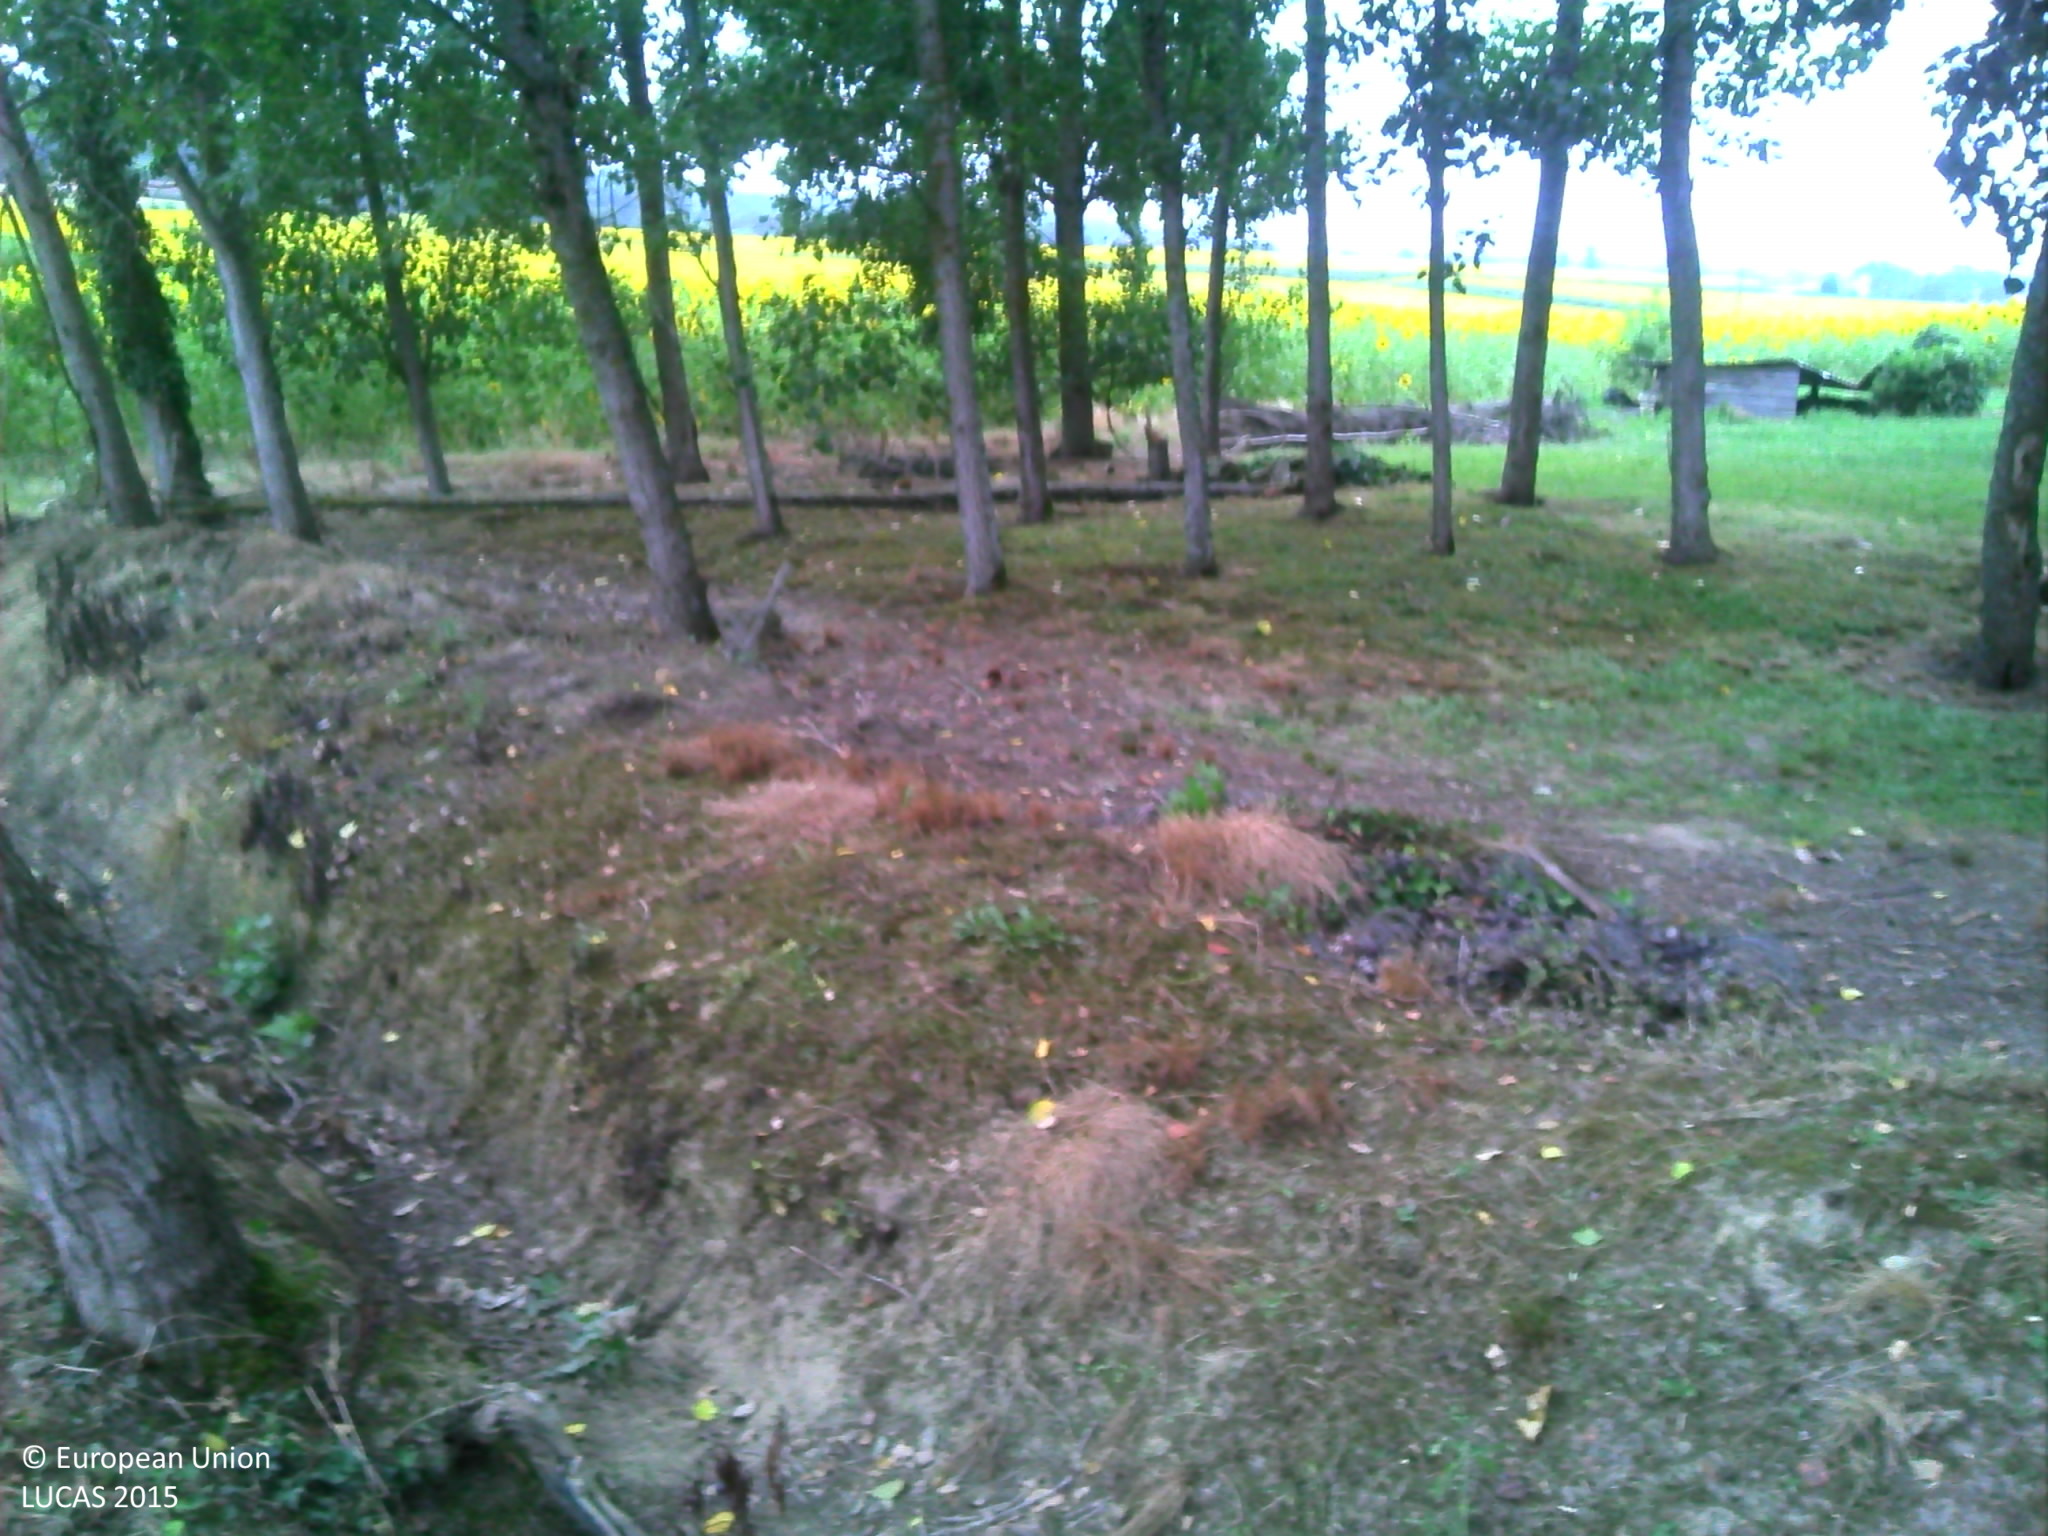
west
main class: Woodland
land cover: Broadleaved woodland
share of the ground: > 75 %
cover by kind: broadleaved forest trees 65 %, herbaceous plants 30 %, consolidated bare surface 5 %
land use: Residential
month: July
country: FR
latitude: 43.6822
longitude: -0.5676
